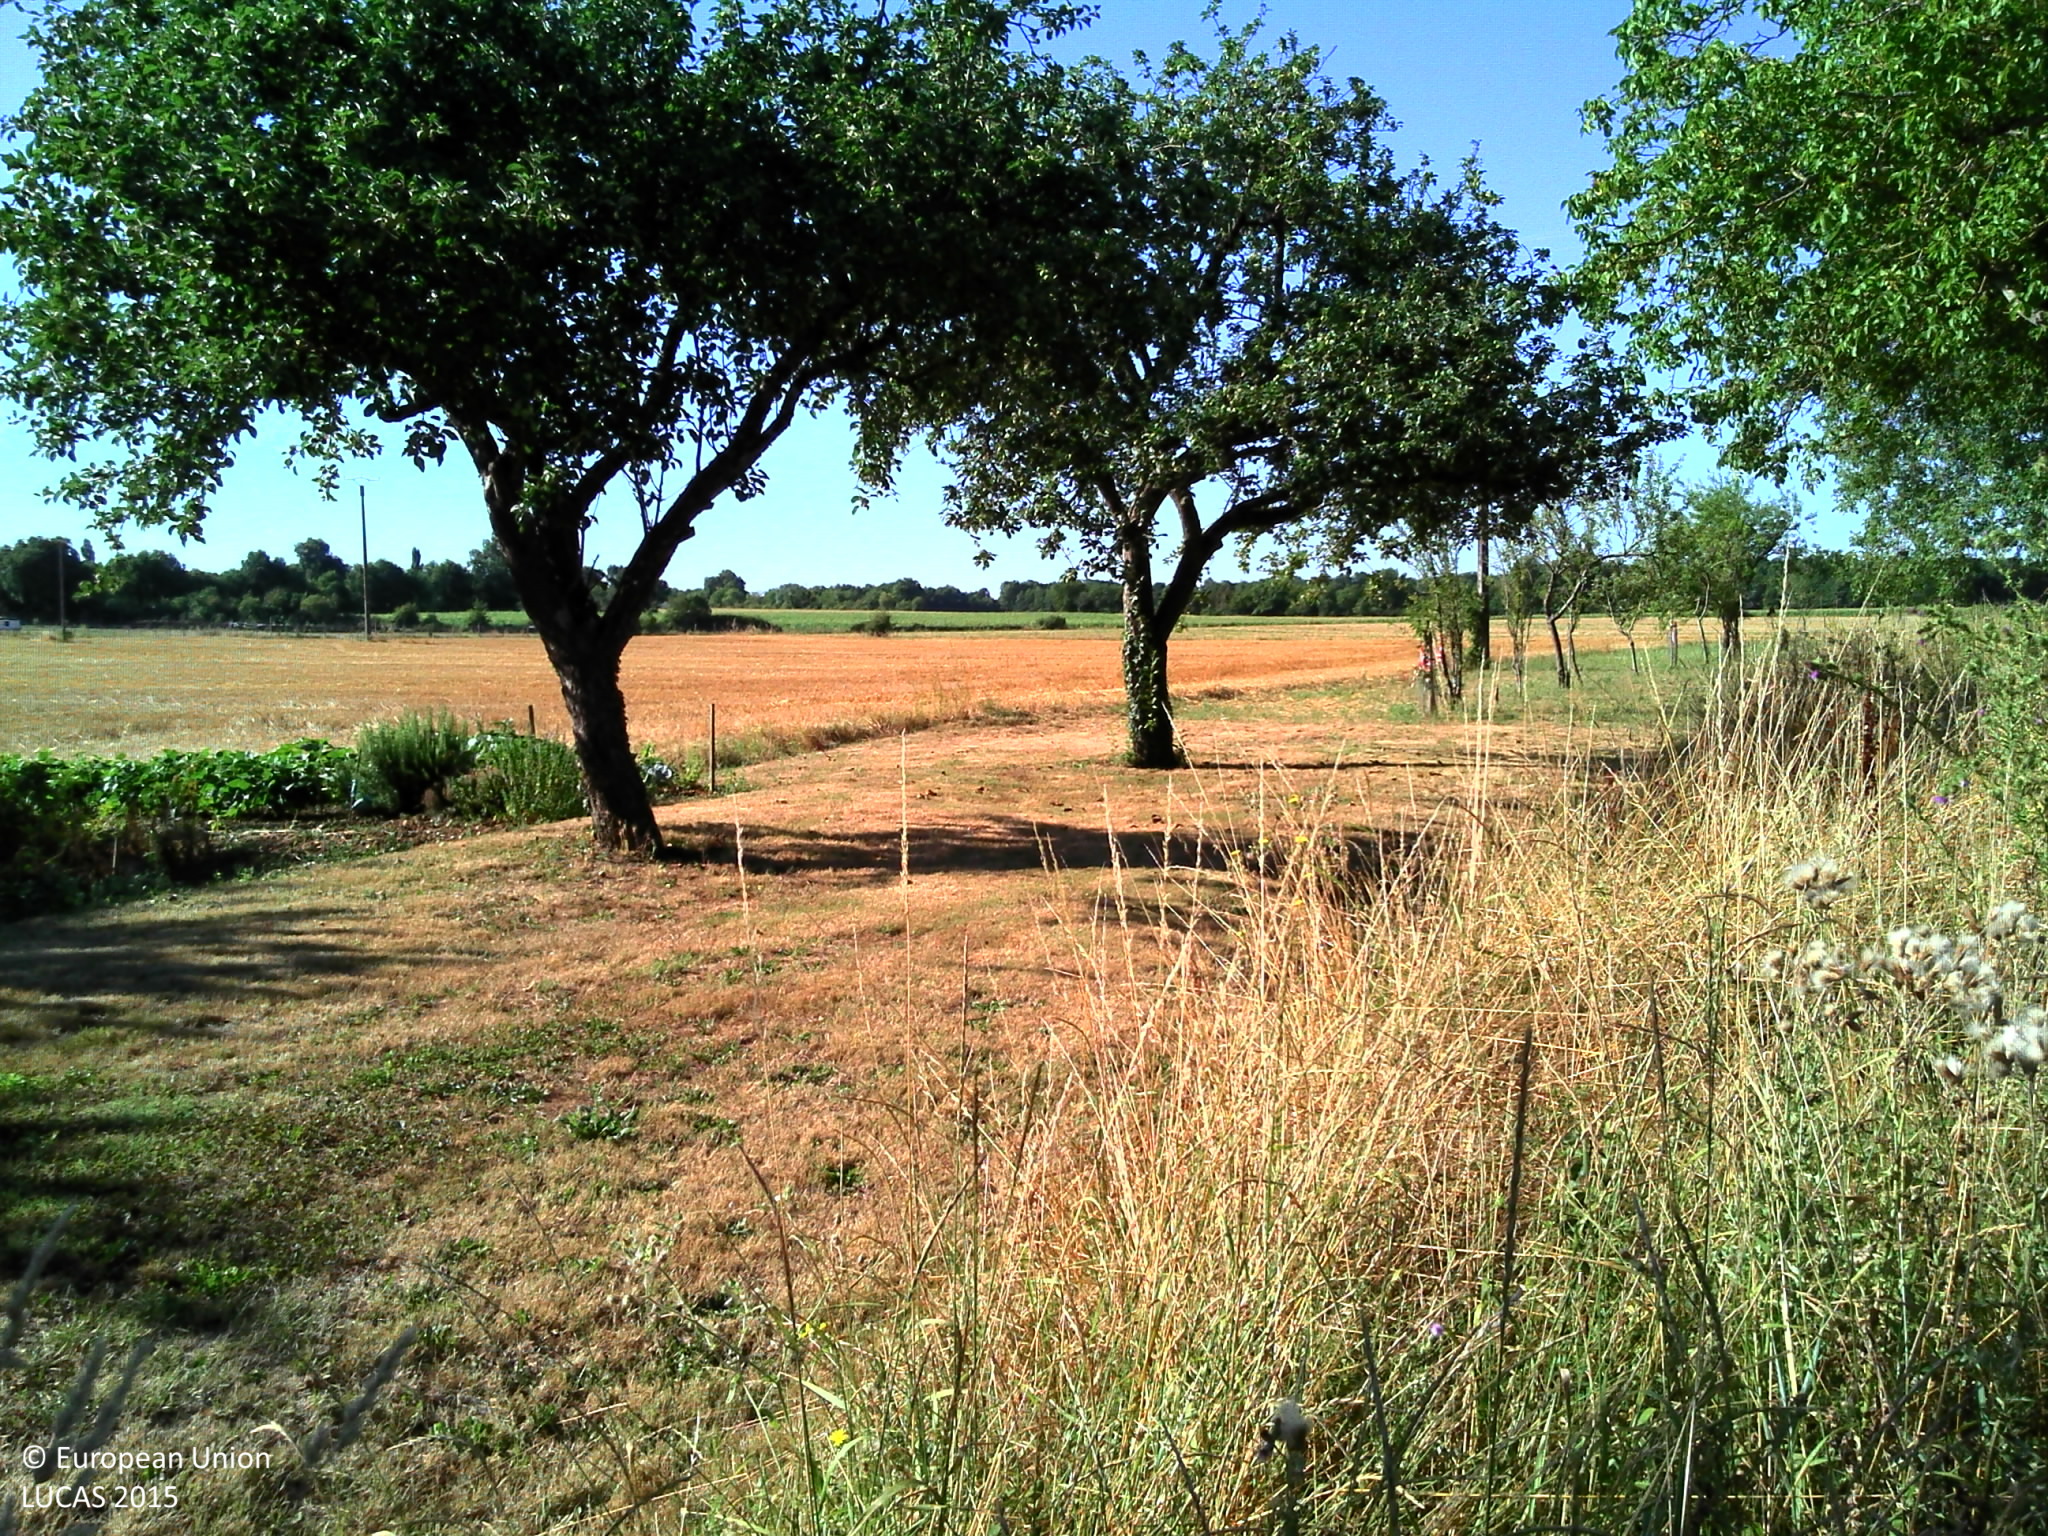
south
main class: Grassland
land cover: Grassland with sparse tree/shrub cover
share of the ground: > 75 %
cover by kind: herbaceous plants 95 %, broadleaved forest trees 5 %
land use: Residential
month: July
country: FR
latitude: 46.3789
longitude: 0.4789
